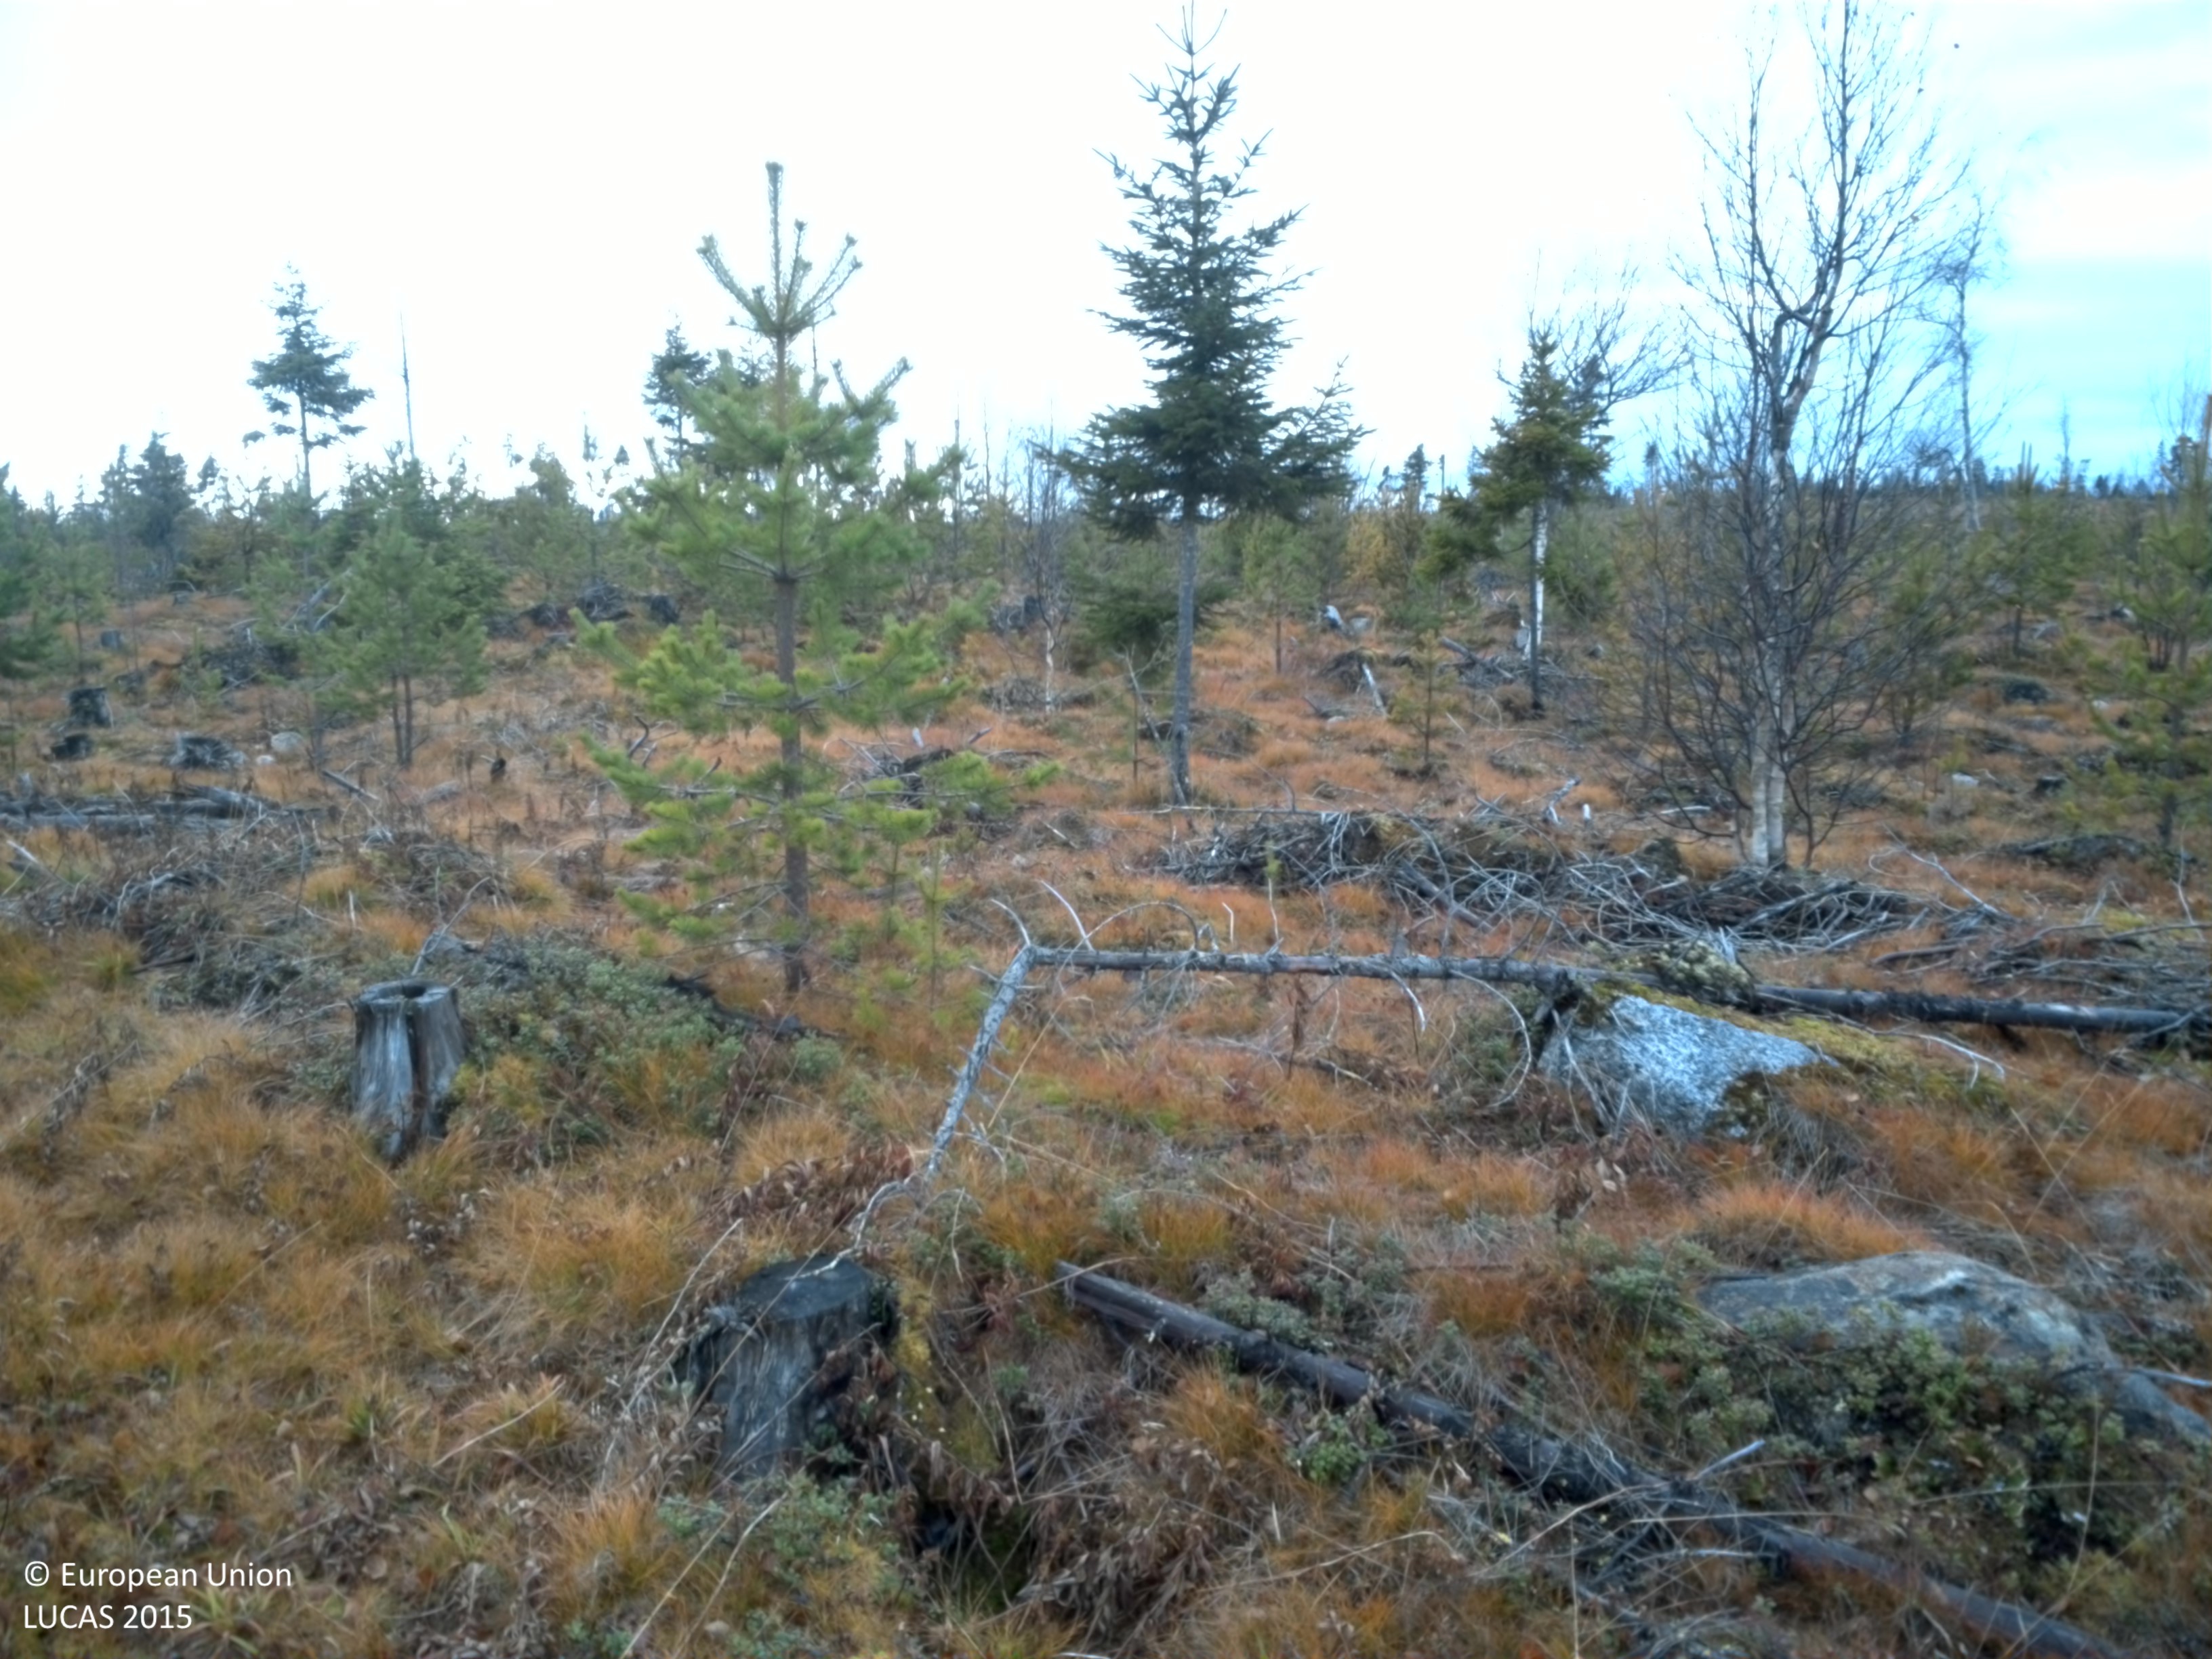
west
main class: Woodland
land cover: Pine dominated mixed woodland
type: boreal forest
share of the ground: 10 - 25 %
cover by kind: herbaceous plants 50 %, shrubs 20 %, lichens and mosses 20 %, coniferous forest trees 5 %, broadleaved forest trees 5 %
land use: Forestry
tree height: < 5 m
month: October
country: SE
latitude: 64.5157
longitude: 17.4035
